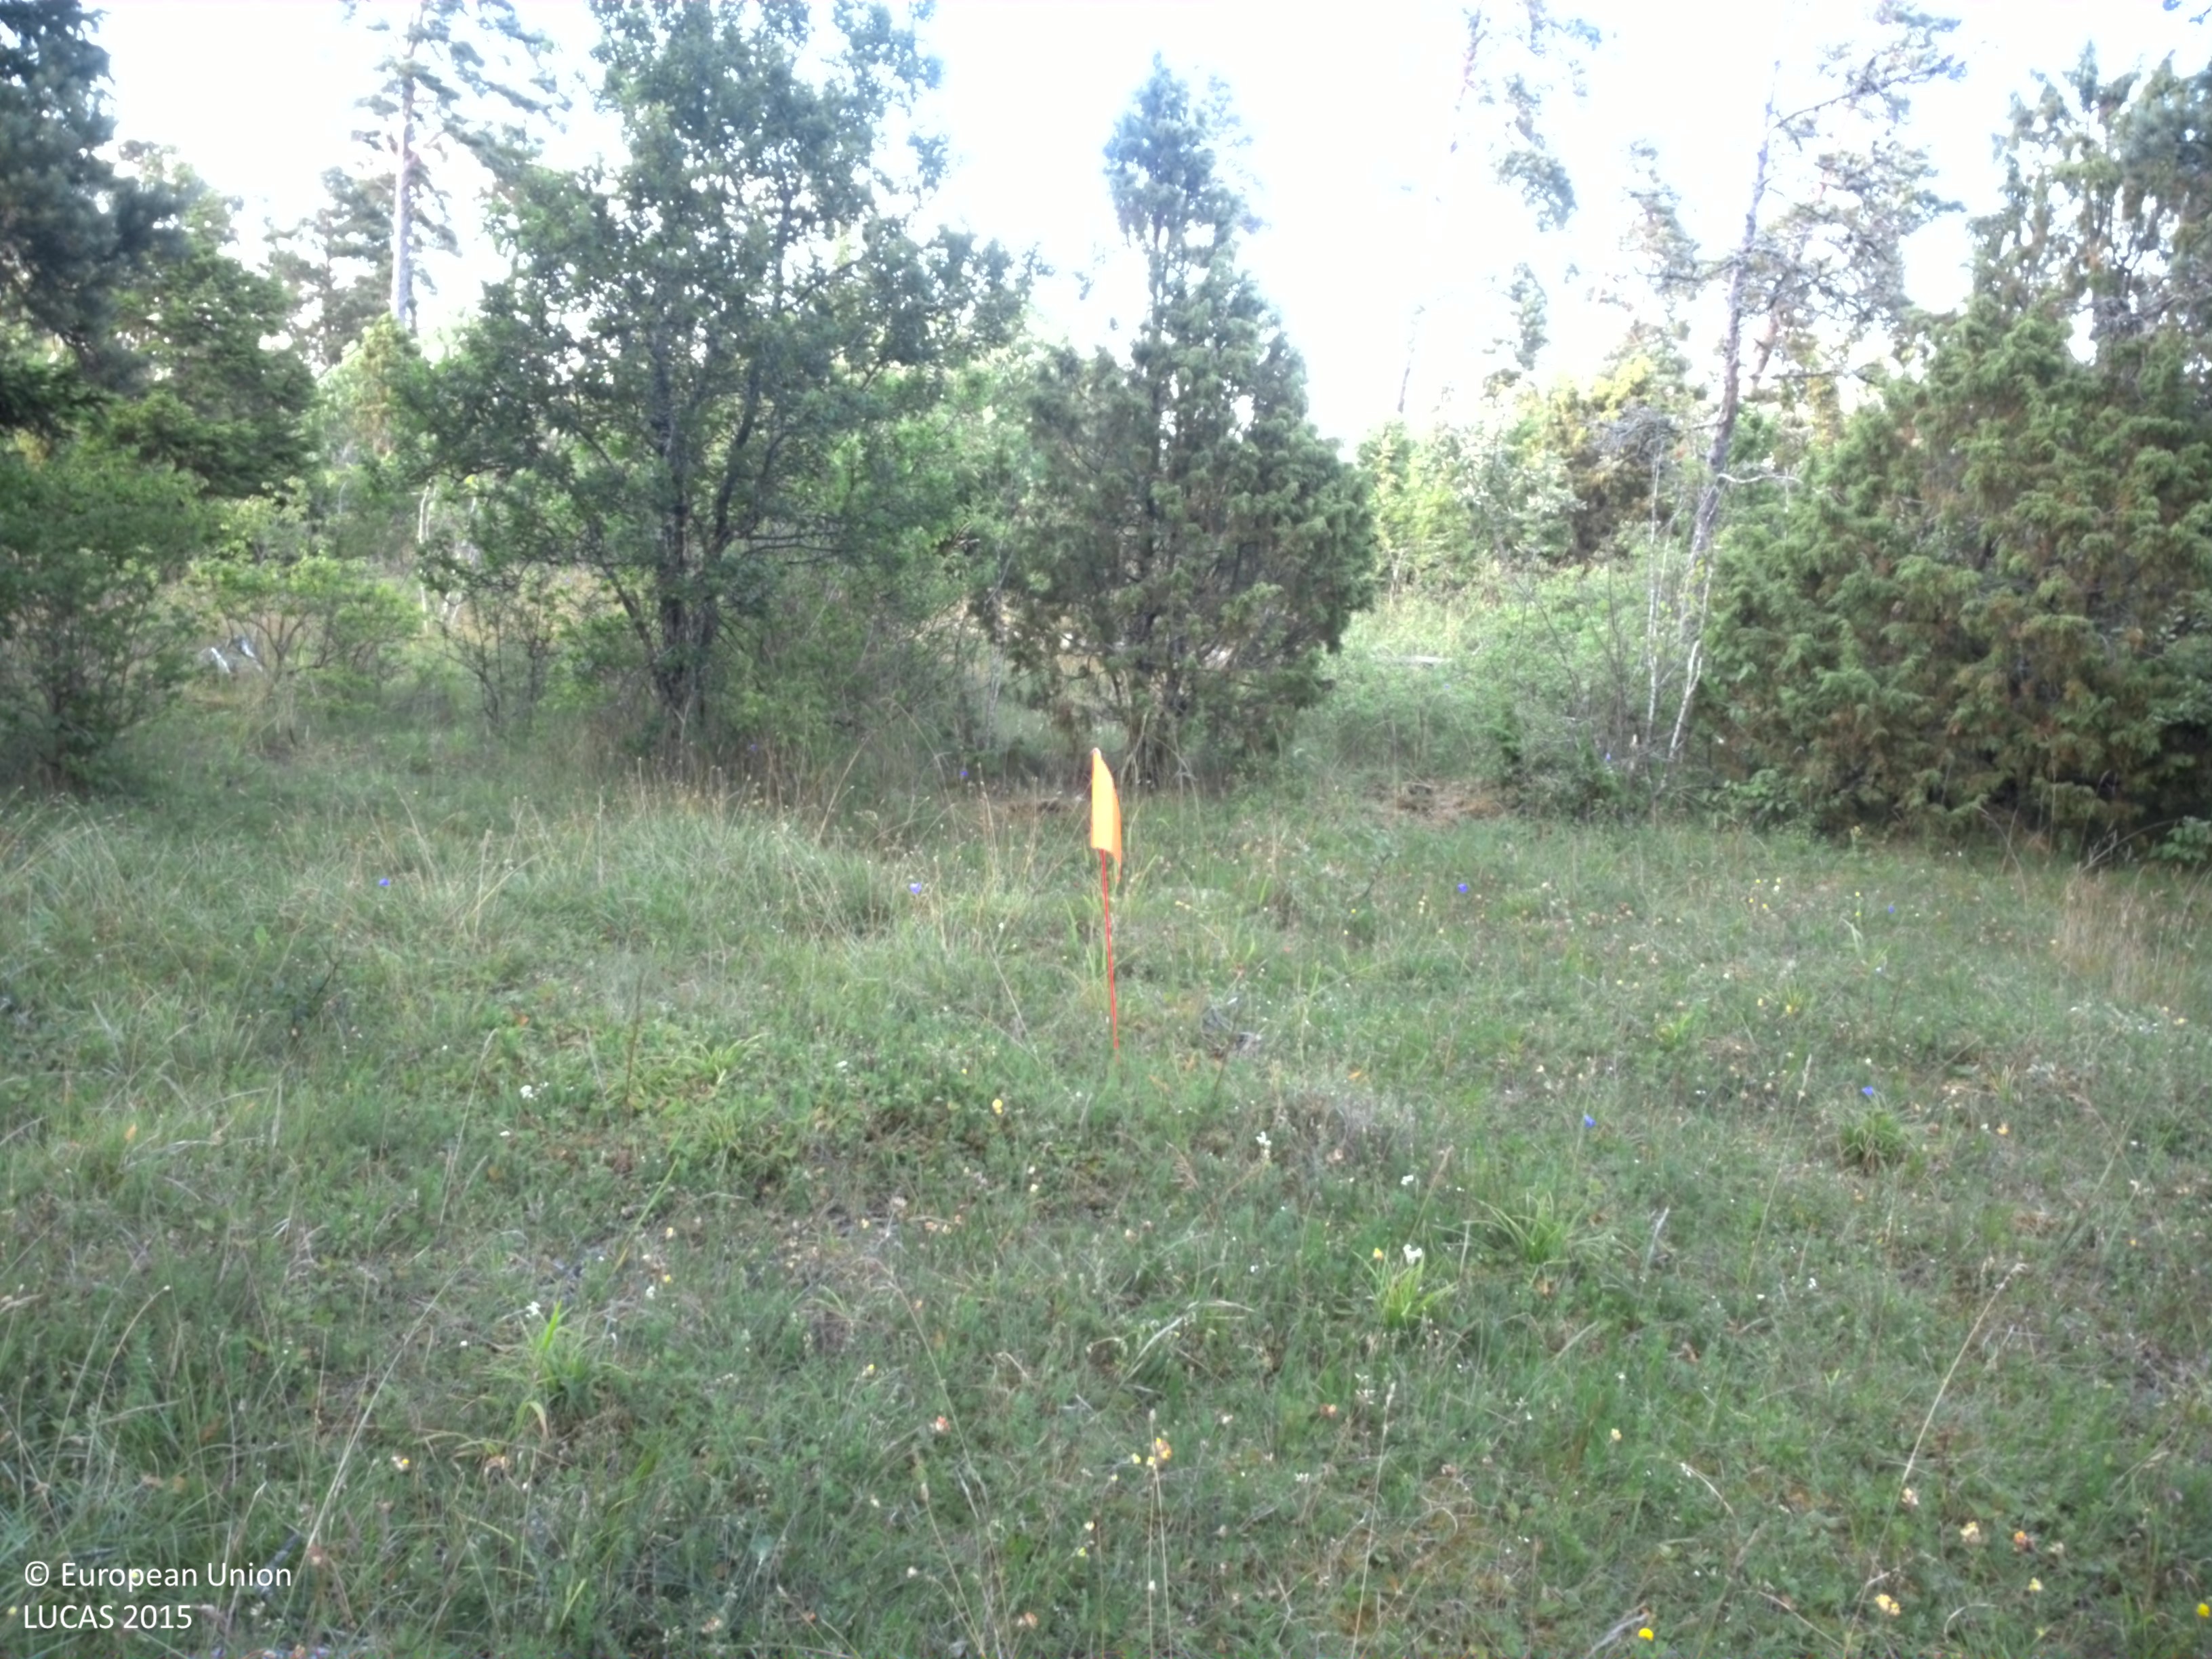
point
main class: Grassland
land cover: Grassland with sparse tree/shrub cover
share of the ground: > 75 %
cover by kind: herbaceous plants 90 %, coniferous forest trees 5 %, shrubs 5 %
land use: Semi-natural and natural areas not in use
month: July
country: SE
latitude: 57.5893
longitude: 18.7589
